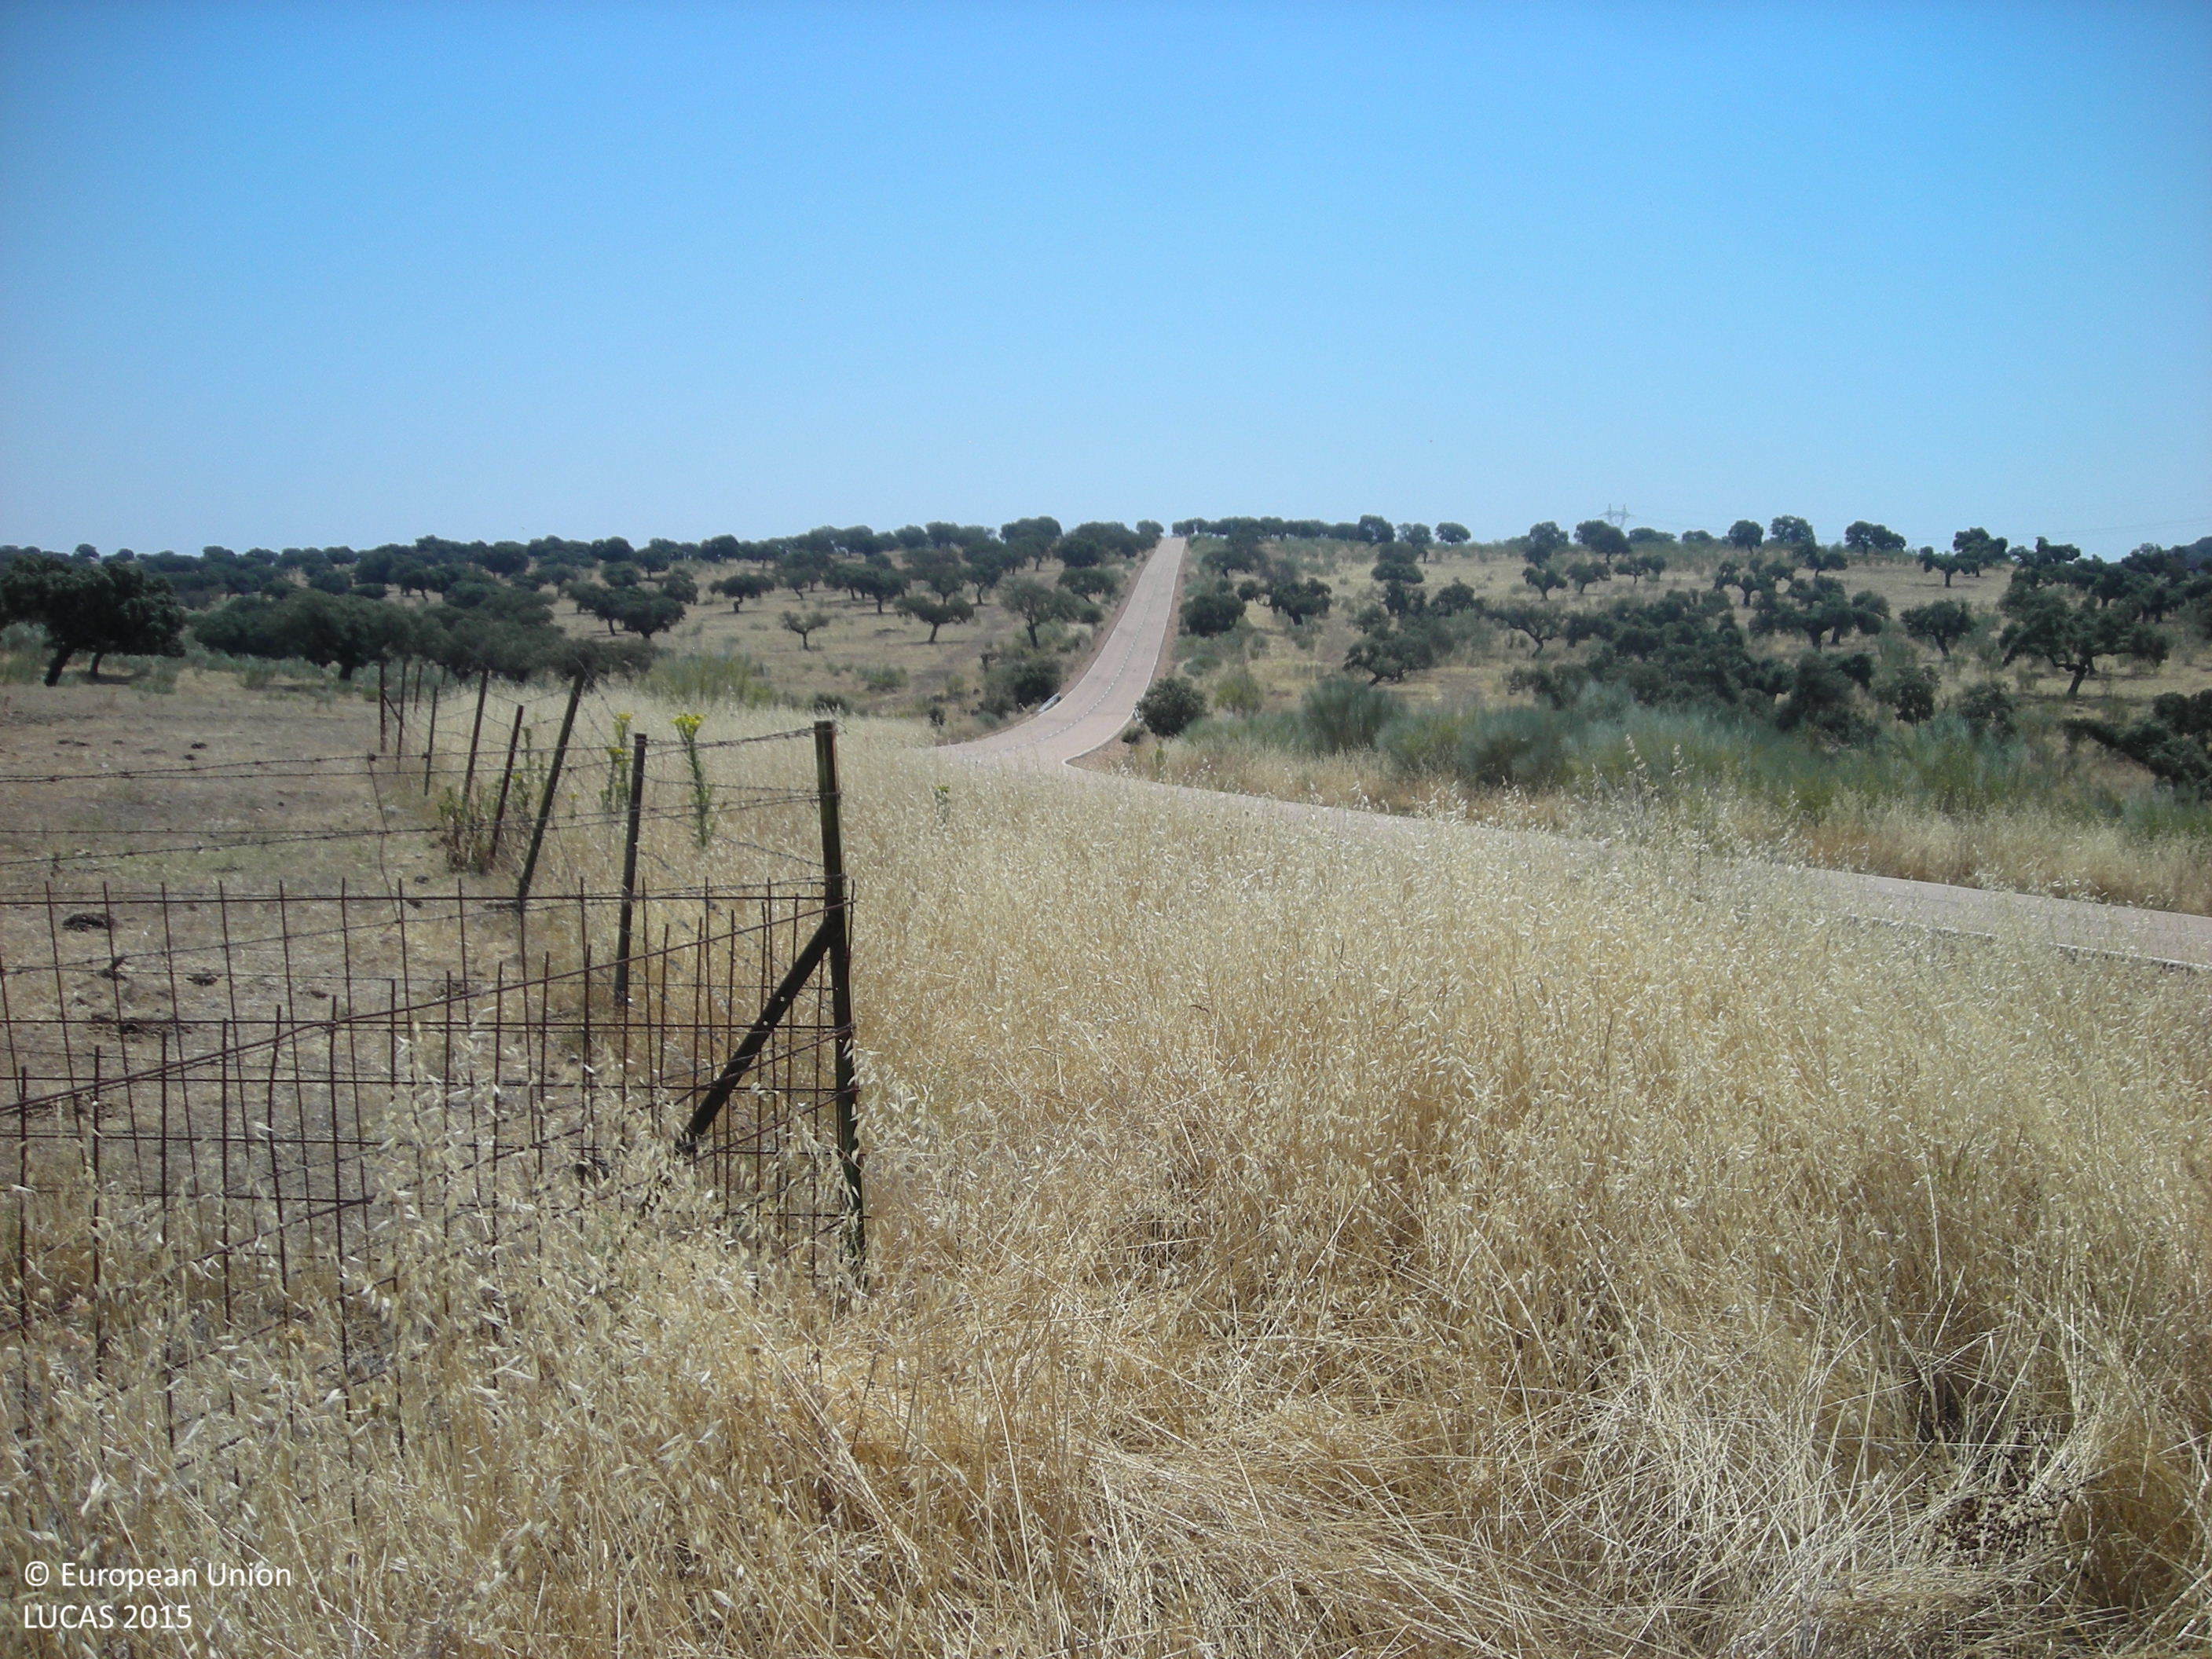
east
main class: Woodland
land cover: Broadleaved woodland
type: broadleaved evergreen forest
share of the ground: 25 - 50 %
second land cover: Grassland without tree/shrub cover
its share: 50 - 75 %
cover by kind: shrubs 60 %, broadleaved forest trees 40 %
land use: Forestry
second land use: Agriculture (excluding fallow land and kitchen gardens)
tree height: > 5 m
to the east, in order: Broadleaved woodland; Grassland without tree/shrub cover; Fences; Broadleaved woodland
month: June
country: ES
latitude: 39.2451
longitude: -5.5164
